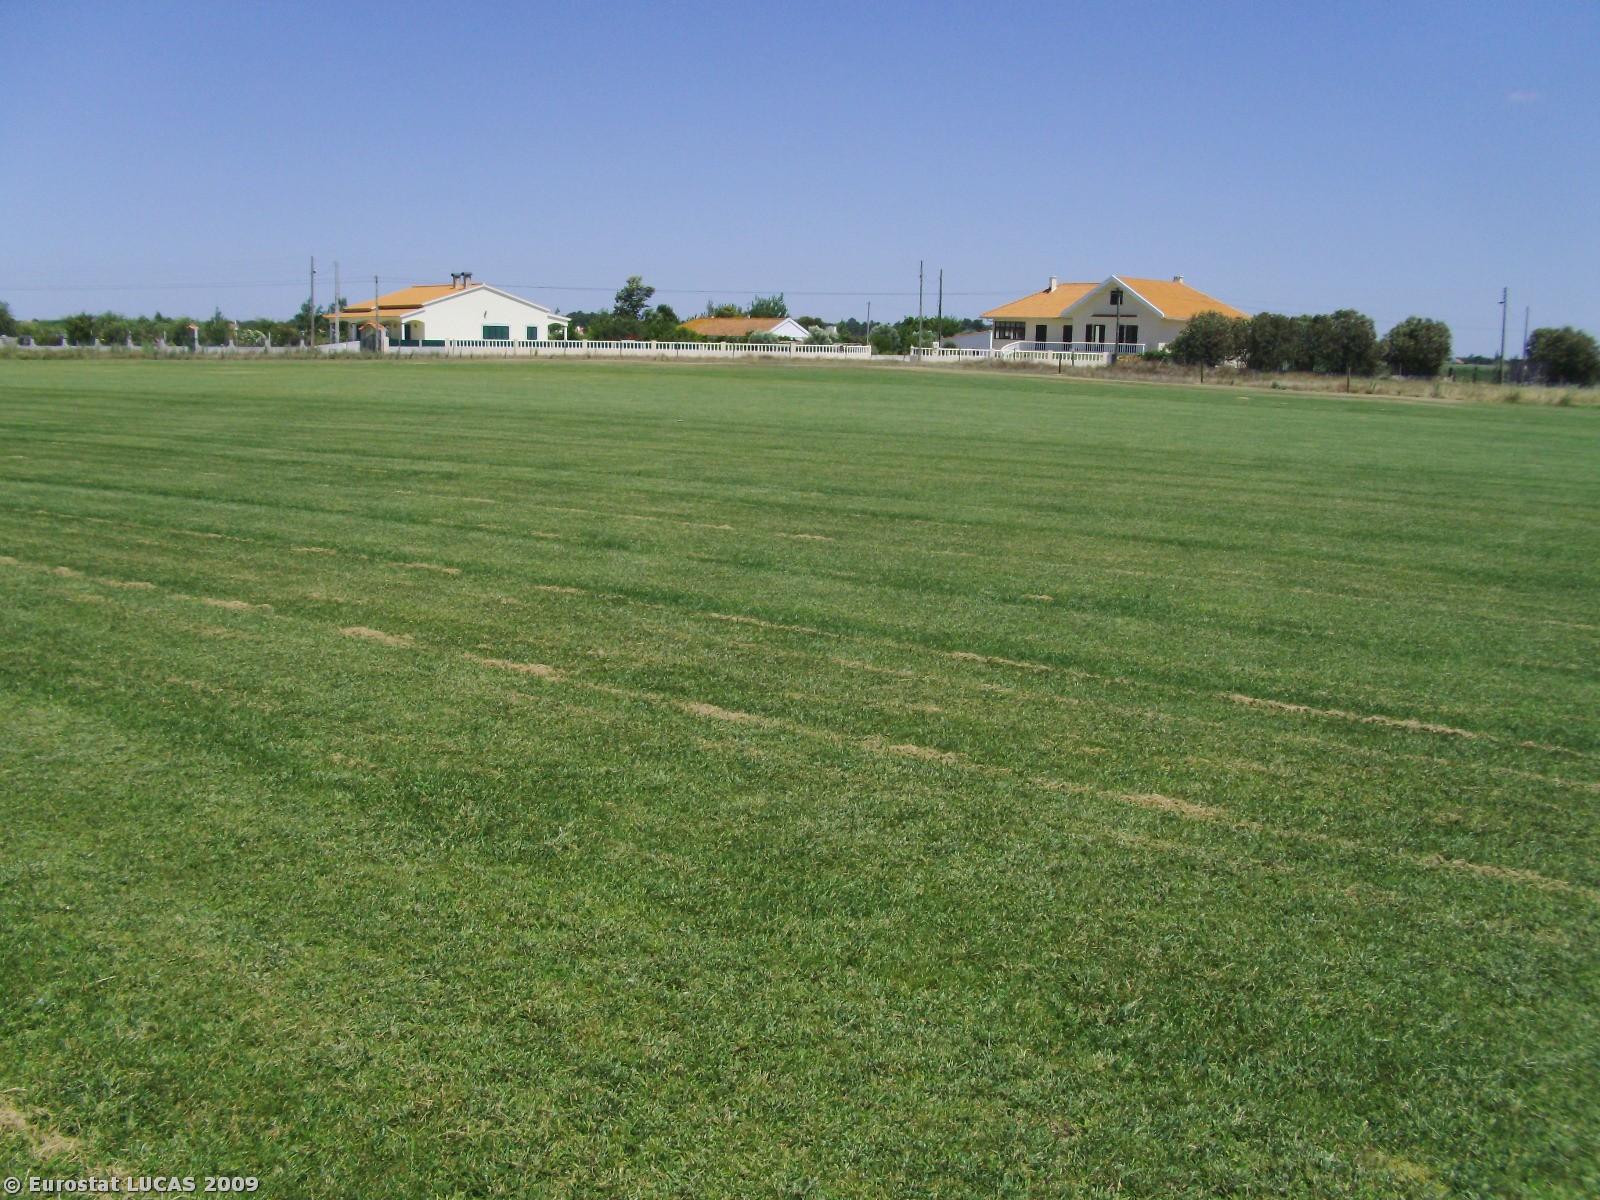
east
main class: Cropland
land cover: Temporary grasslands
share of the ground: > 75 %
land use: Agriculture (excluding fallow land and kitchen gardens)
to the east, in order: Temporary grasslands; Spontaneously vegetated surfaces; Fences; Electric lines; Grass margins; Paved roads, cycling and walking lanes; Grass margins; Electric lines; Dry stone walls; Grassland without tree/shrub cover; Dry stone walls; Tracks; Artificial constructions in urban areas; Lines of trees; Arable land (only in case pi); Artificial constructions in urban areas; Single bushes/trees; Broadleaved woodland; Arable land (only in case pi)
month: July
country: PT
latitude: 39.0073
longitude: -8.7901
